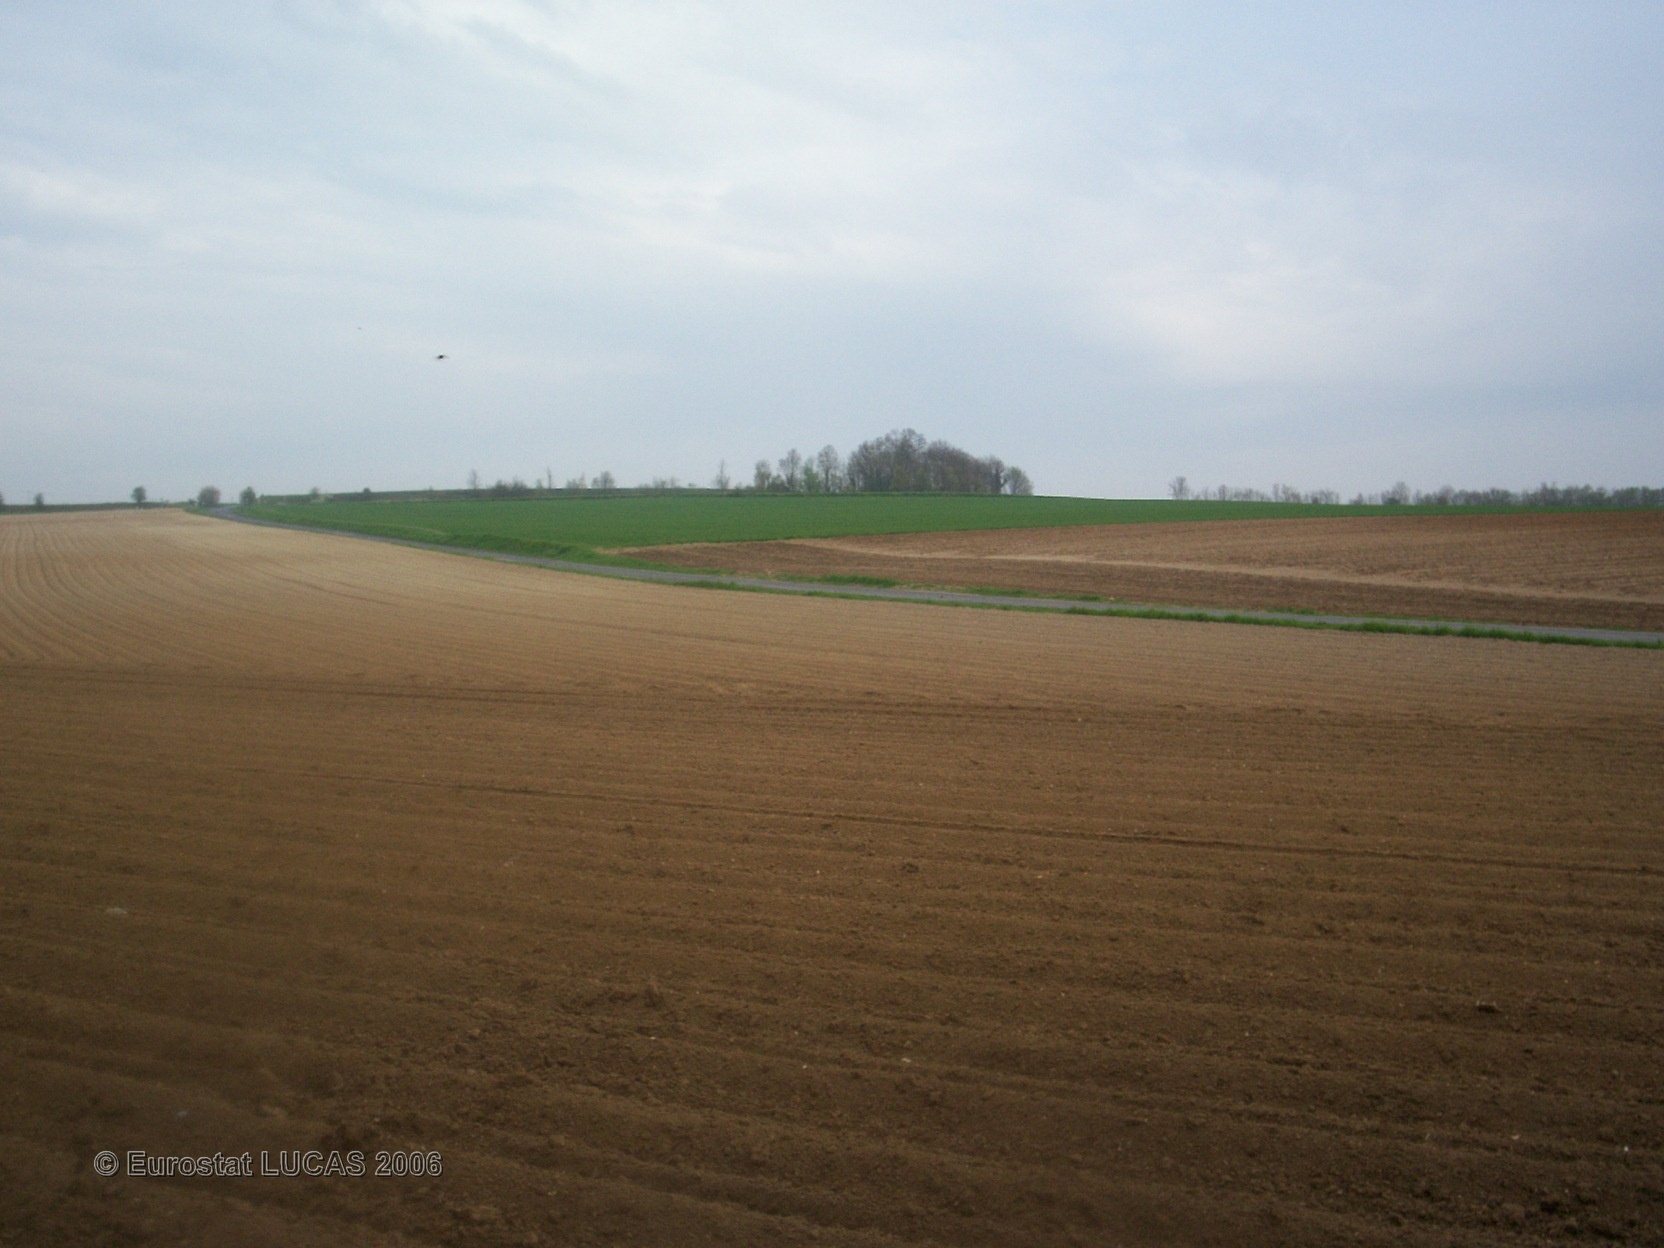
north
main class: Cropland
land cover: Potatoes
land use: Agriculture (excluding fallow land and kitchen gardens)
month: April
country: FR
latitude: 49.9787
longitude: 2.5833
